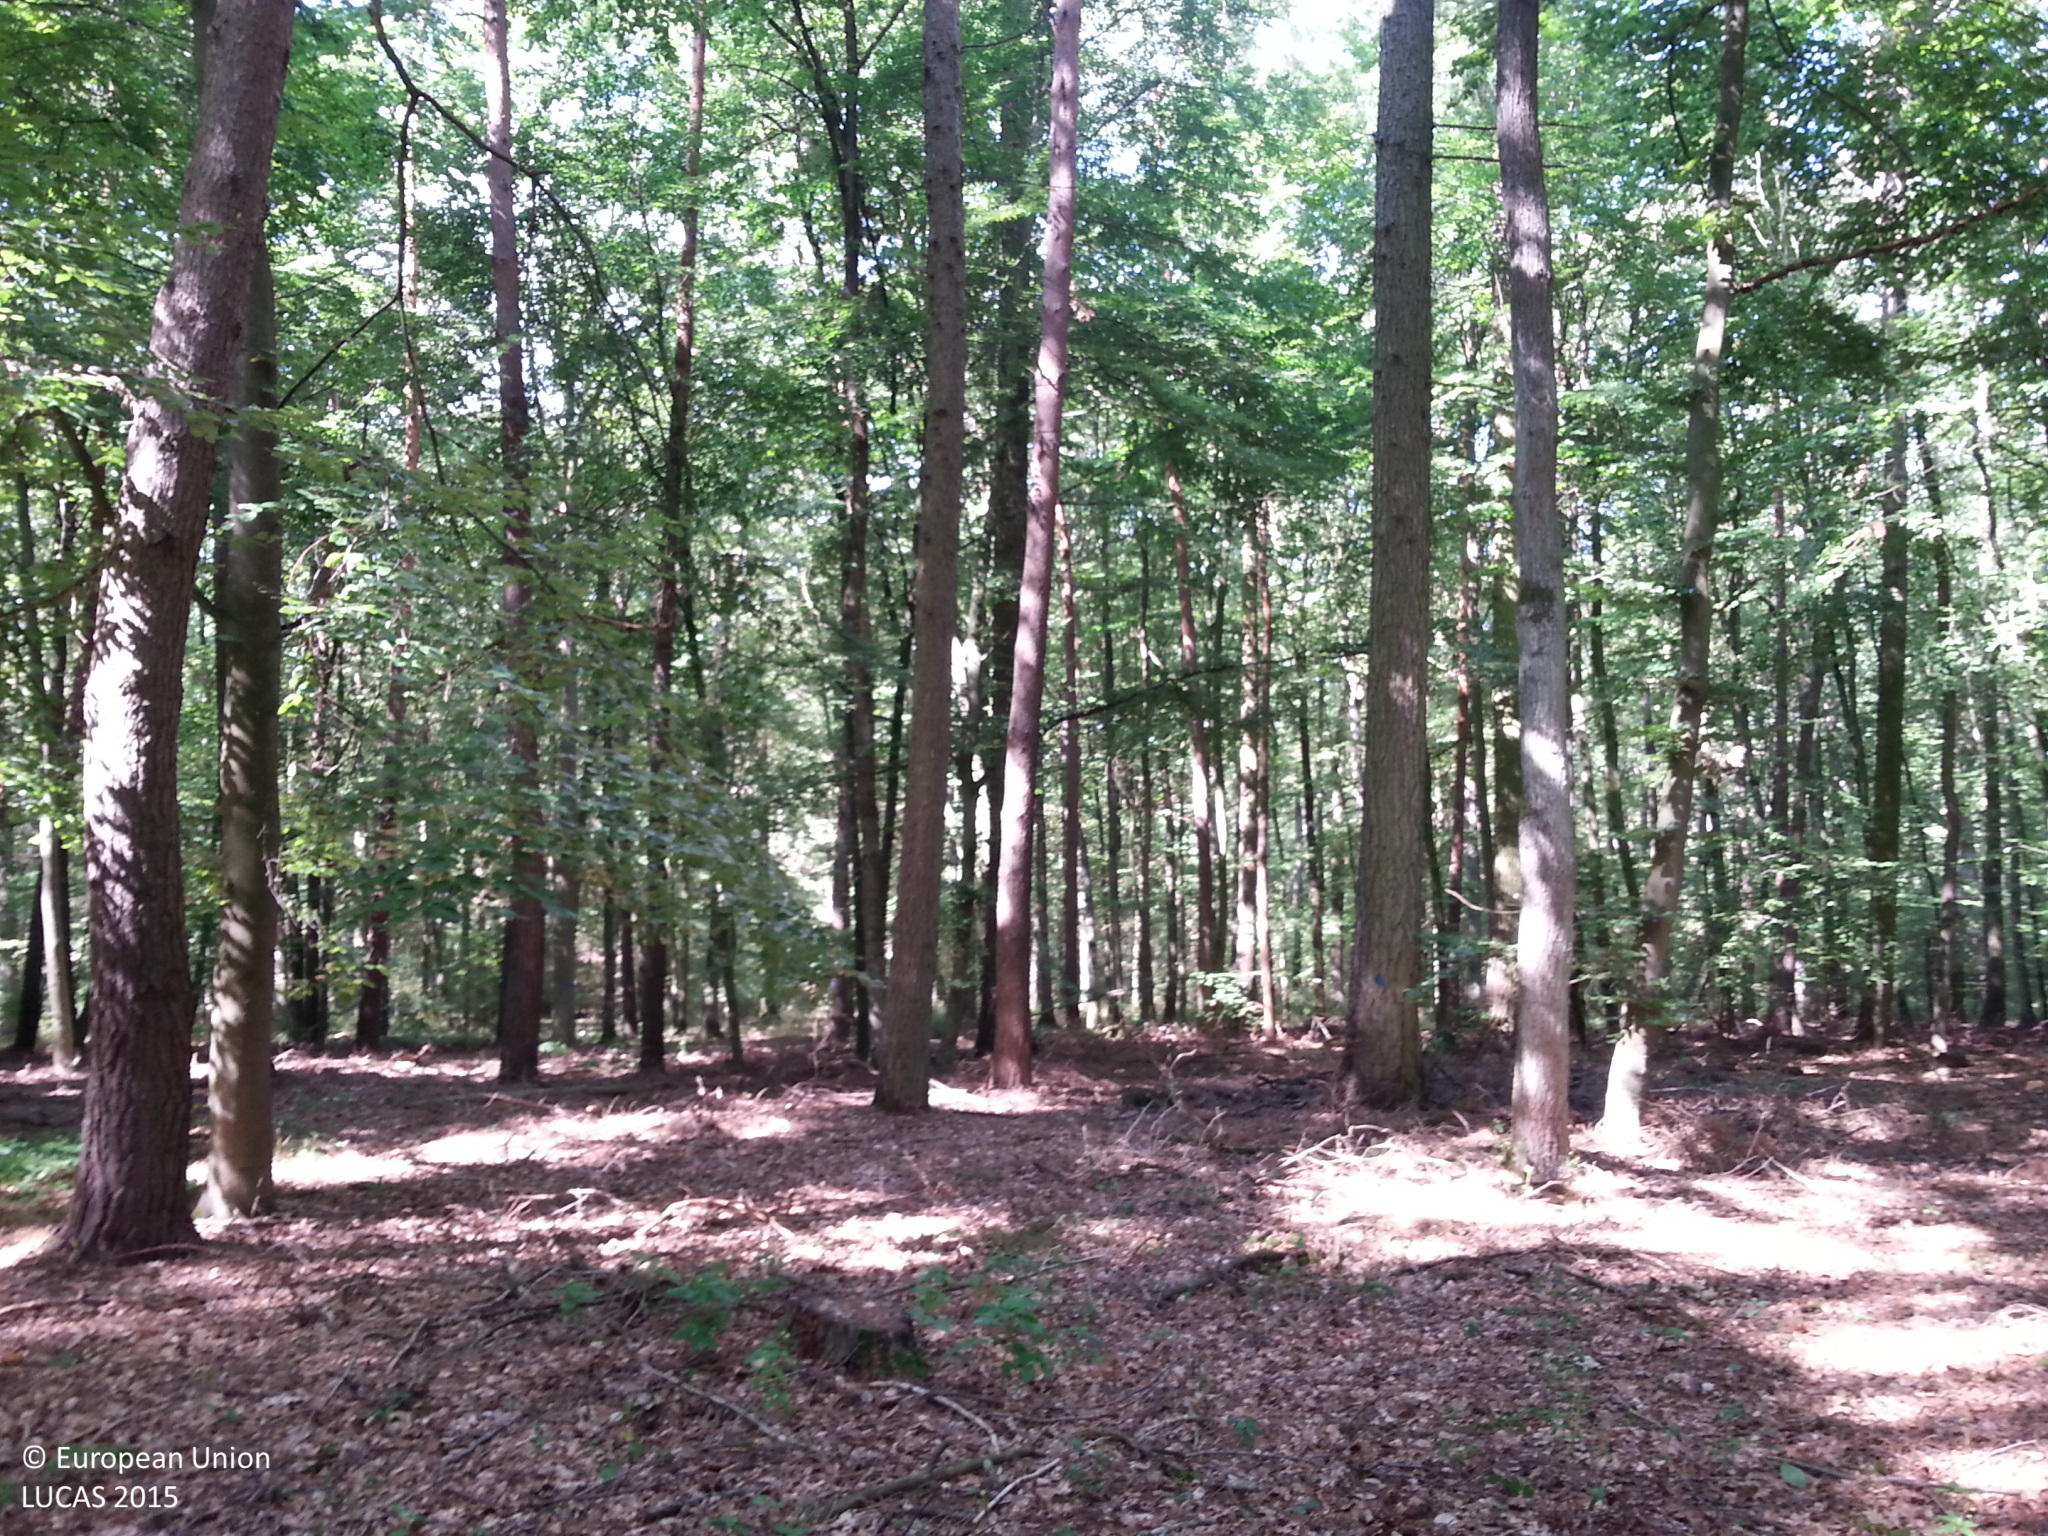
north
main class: Woodland
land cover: Other mixed woodland
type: hemiboreal forest and nemoral coniferous forest and mixed broadleaved-coniferous forest
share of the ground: > 75 %
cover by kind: broadleaved forest trees 50 %, coniferous forest trees 40 %, unconsolidated bare surface 10 %
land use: Forestry
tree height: > 5 m
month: August
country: DE
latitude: 49.4649
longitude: 9.9586
